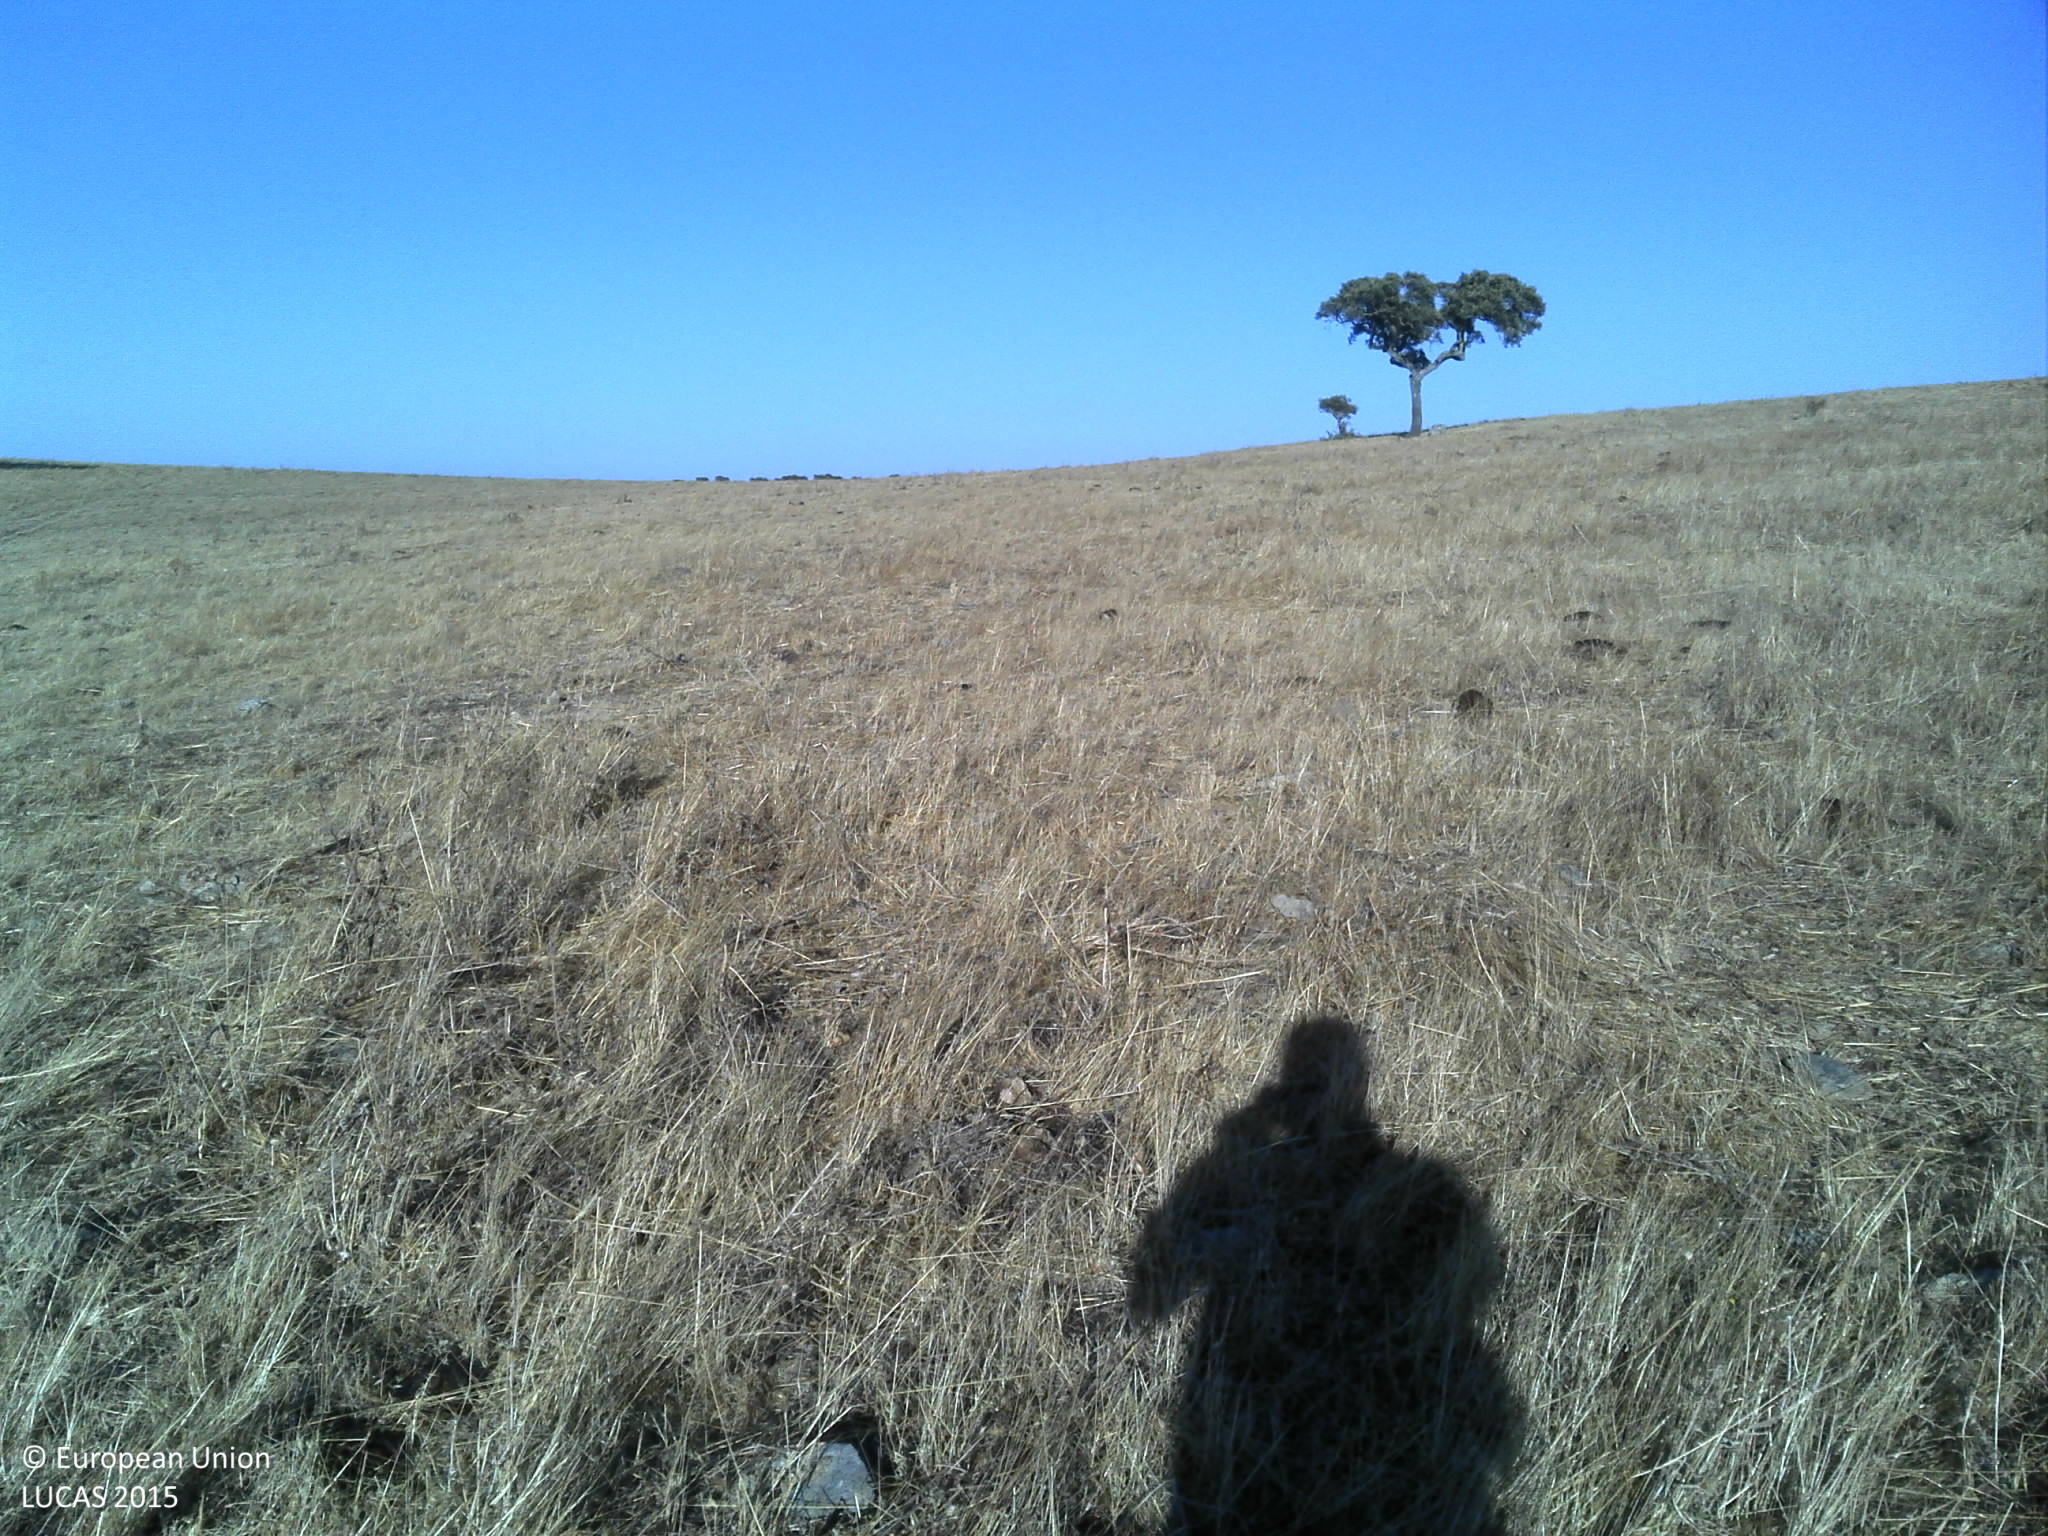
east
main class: Grassland
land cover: Grassland with sparse tree/shrub cover
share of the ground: > 75 %
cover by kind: herbaceous plants 90 %, broadleaved forest trees 5 %, unconsolidated bare surface 5 %
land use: Agriculture (excluding fallow land and kitchen gardens)
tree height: < 5 m
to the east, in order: Grassland with sparse tree/shrub cover; Tracks; Grass margins; Fences; Shruby margins; Other structural elements; Broadleaved woodland; Other structural elements
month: July
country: PT
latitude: 37.7208
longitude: -7.9838
